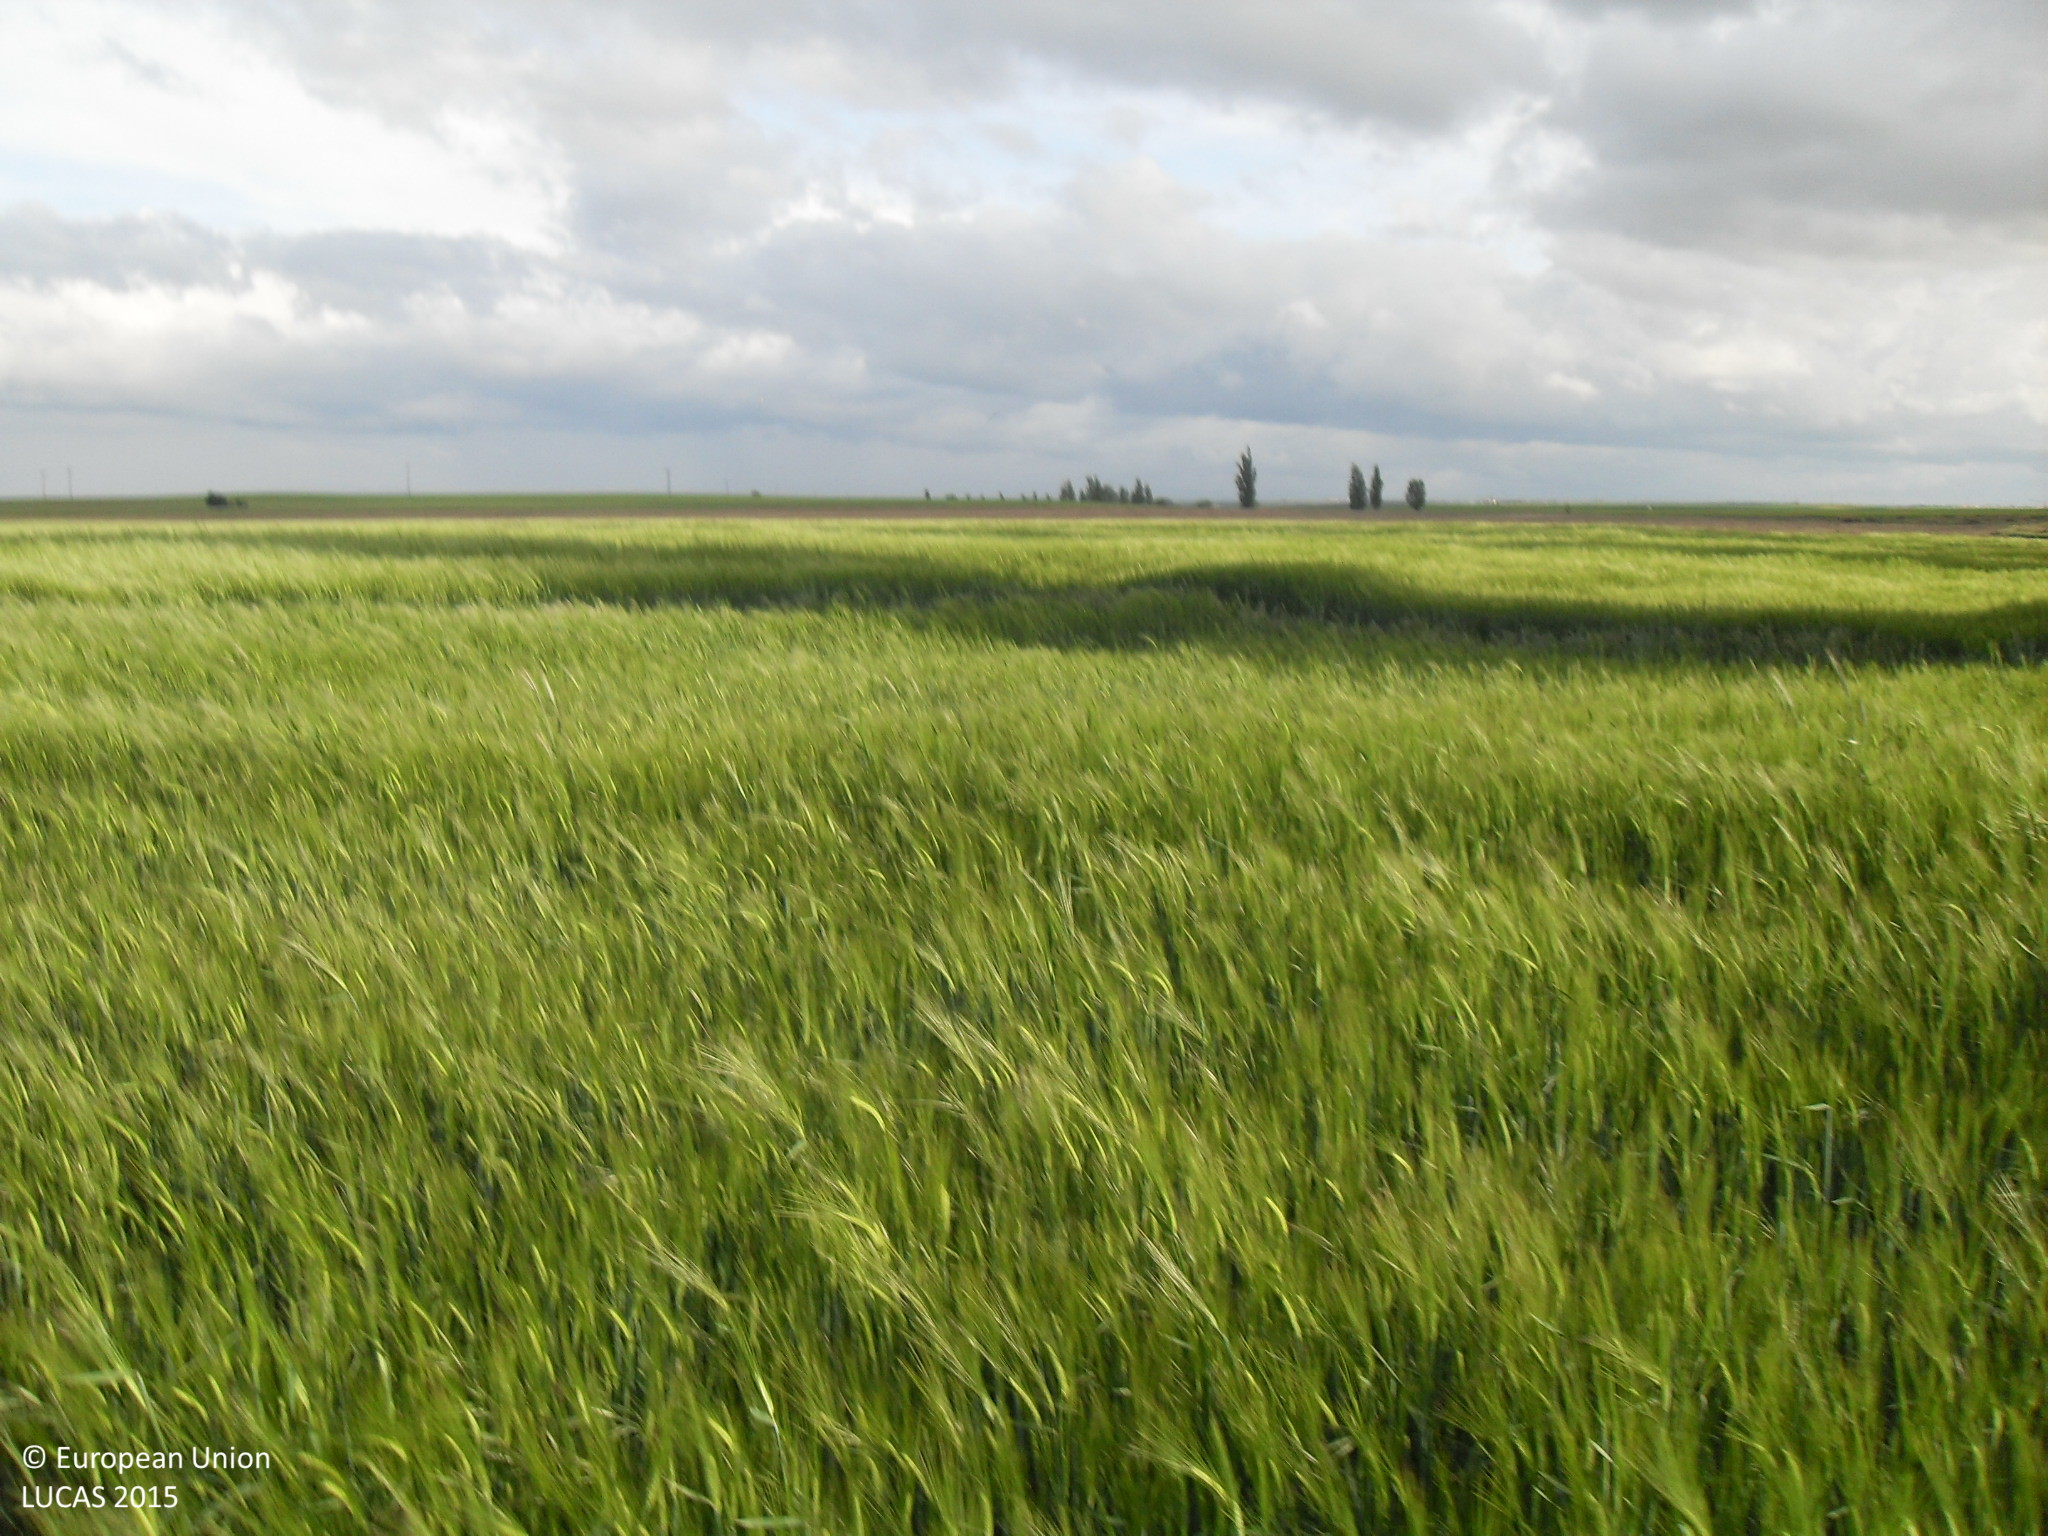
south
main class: Cropland
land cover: Barley
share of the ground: > 75 %
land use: Agriculture (excluding fallow land and kitchen gardens)
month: May
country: ES
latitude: 40.9713
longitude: -5.1718
